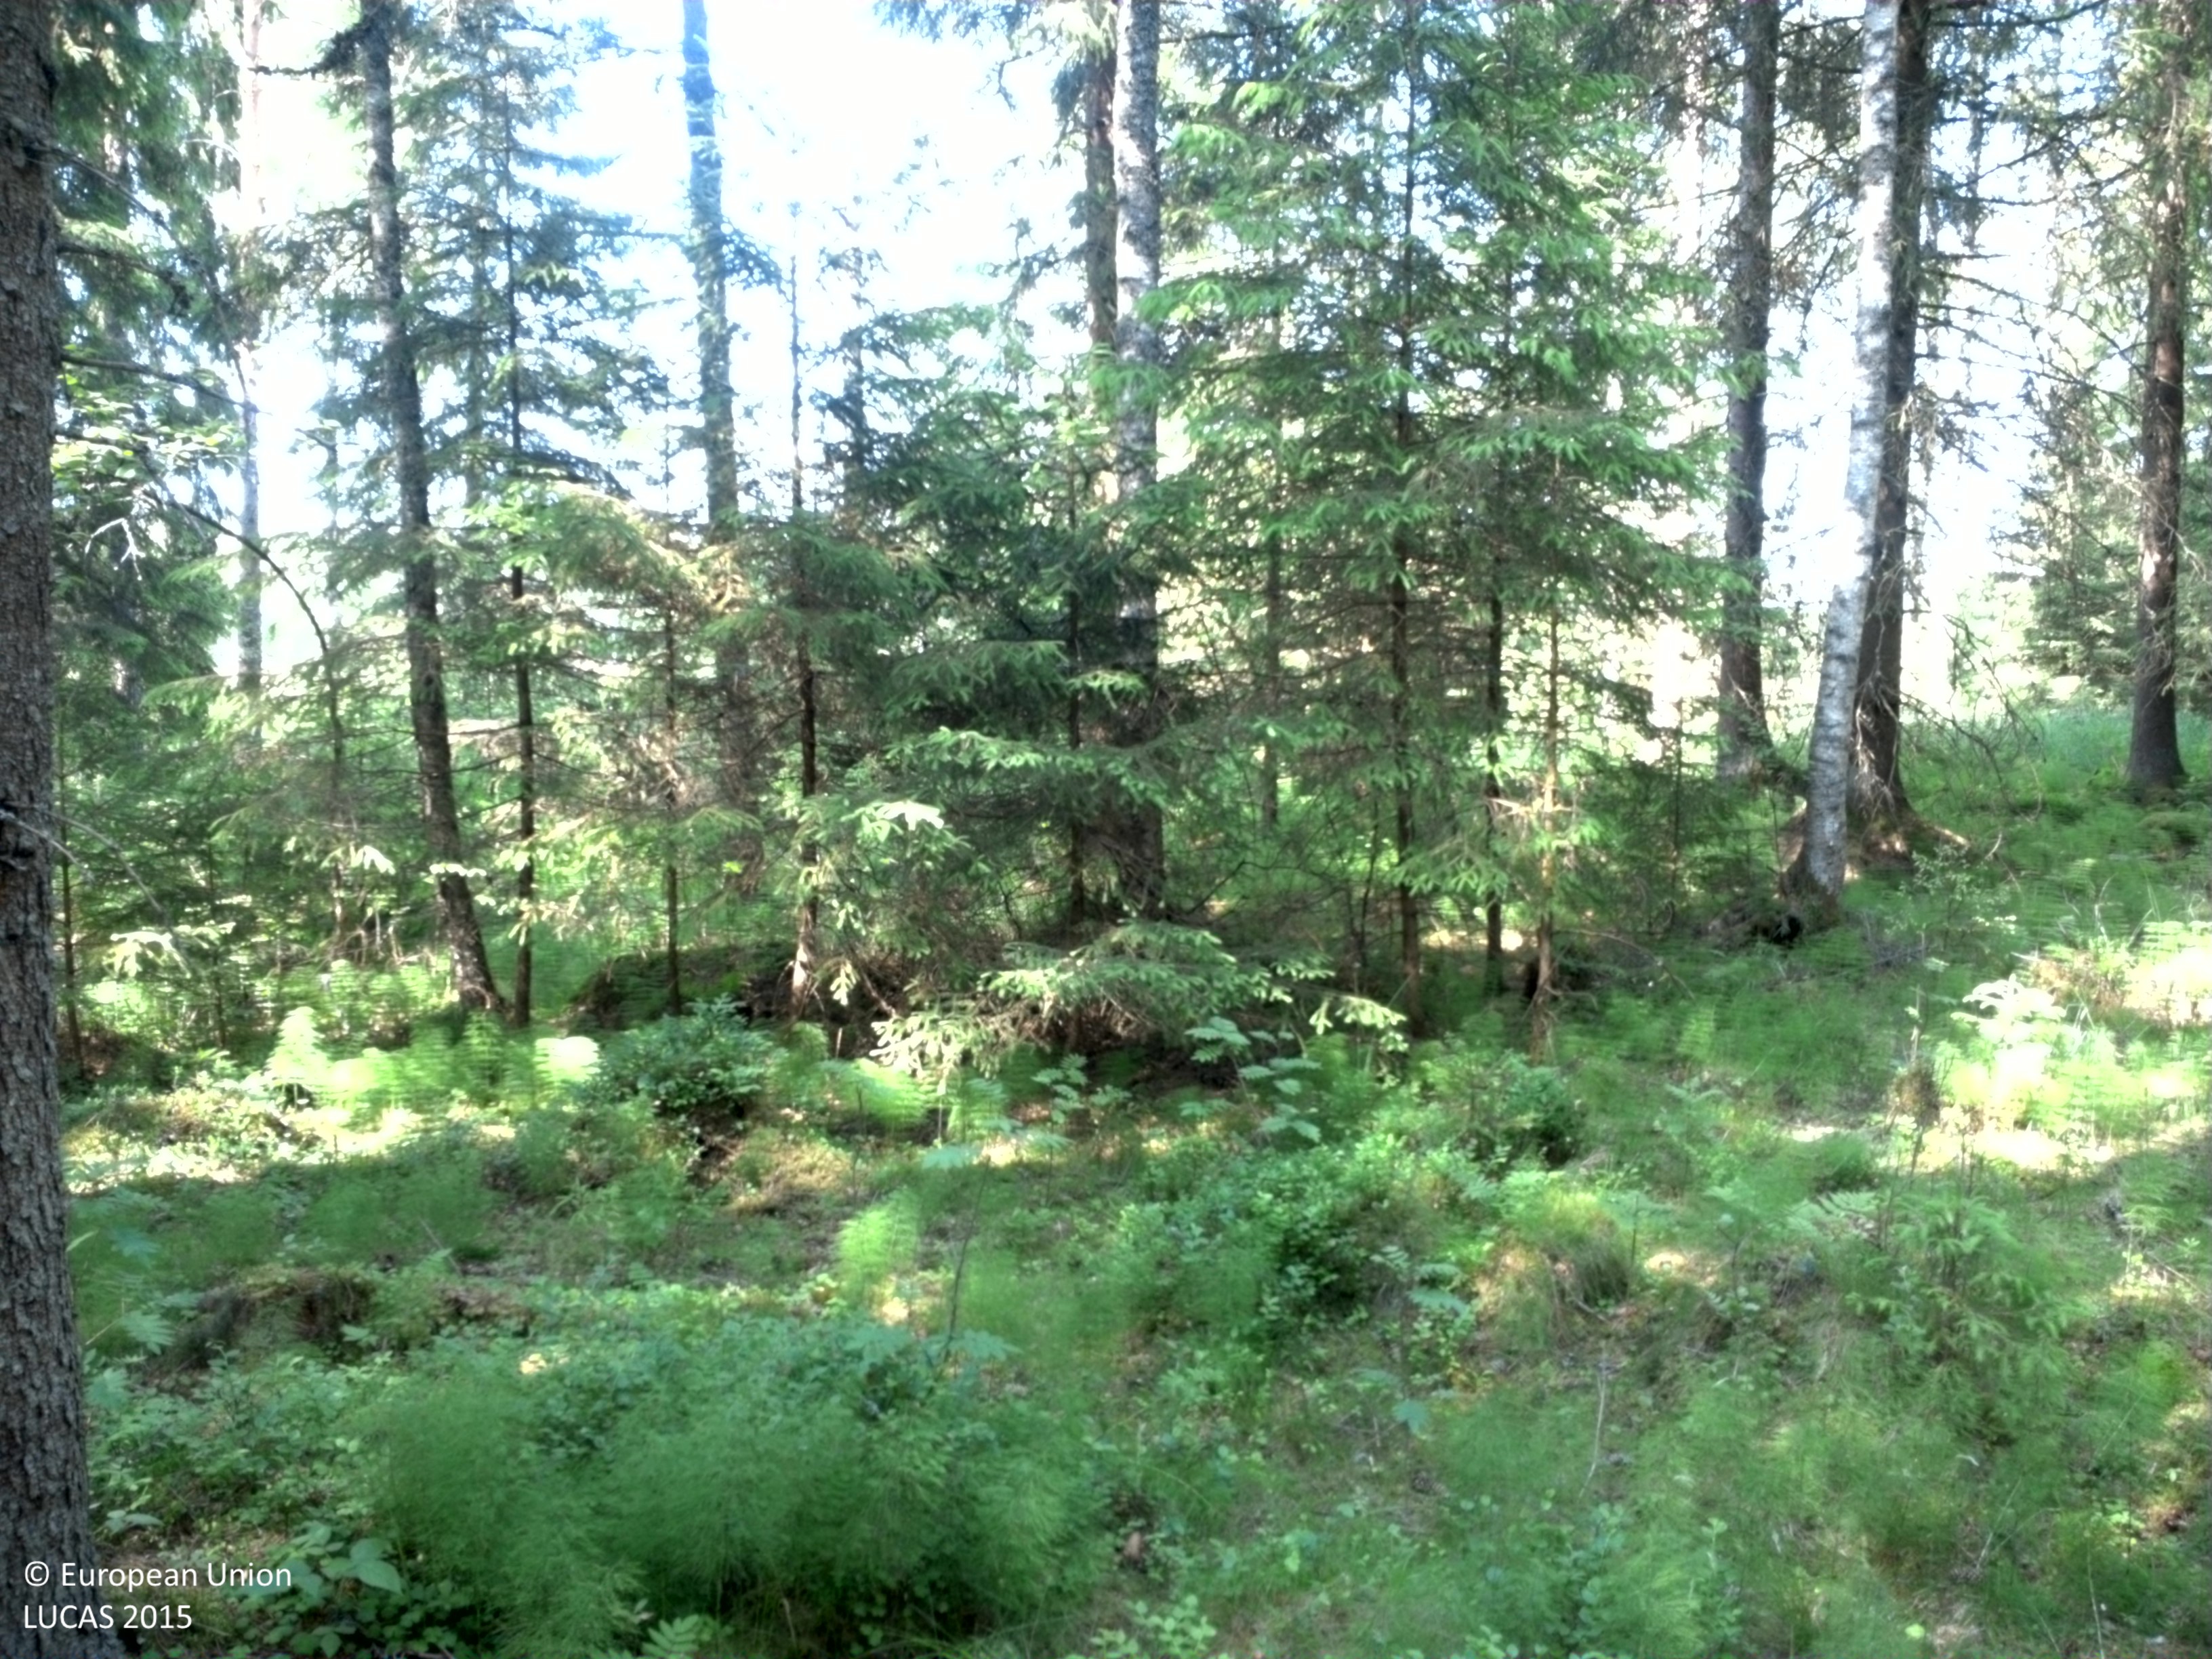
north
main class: Woodland
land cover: Spruce dominated coniferous woodland
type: boreal forest
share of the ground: 50 - 75 %
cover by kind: coniferous forest trees 70 %, shrubs 10 %, lichens and mosses 10 %, broadleaved forest trees 5 %, herbaceous plants 5 %
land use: Forestry
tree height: > 5 m
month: July
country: SE
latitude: 57.6219
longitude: 13.9299
